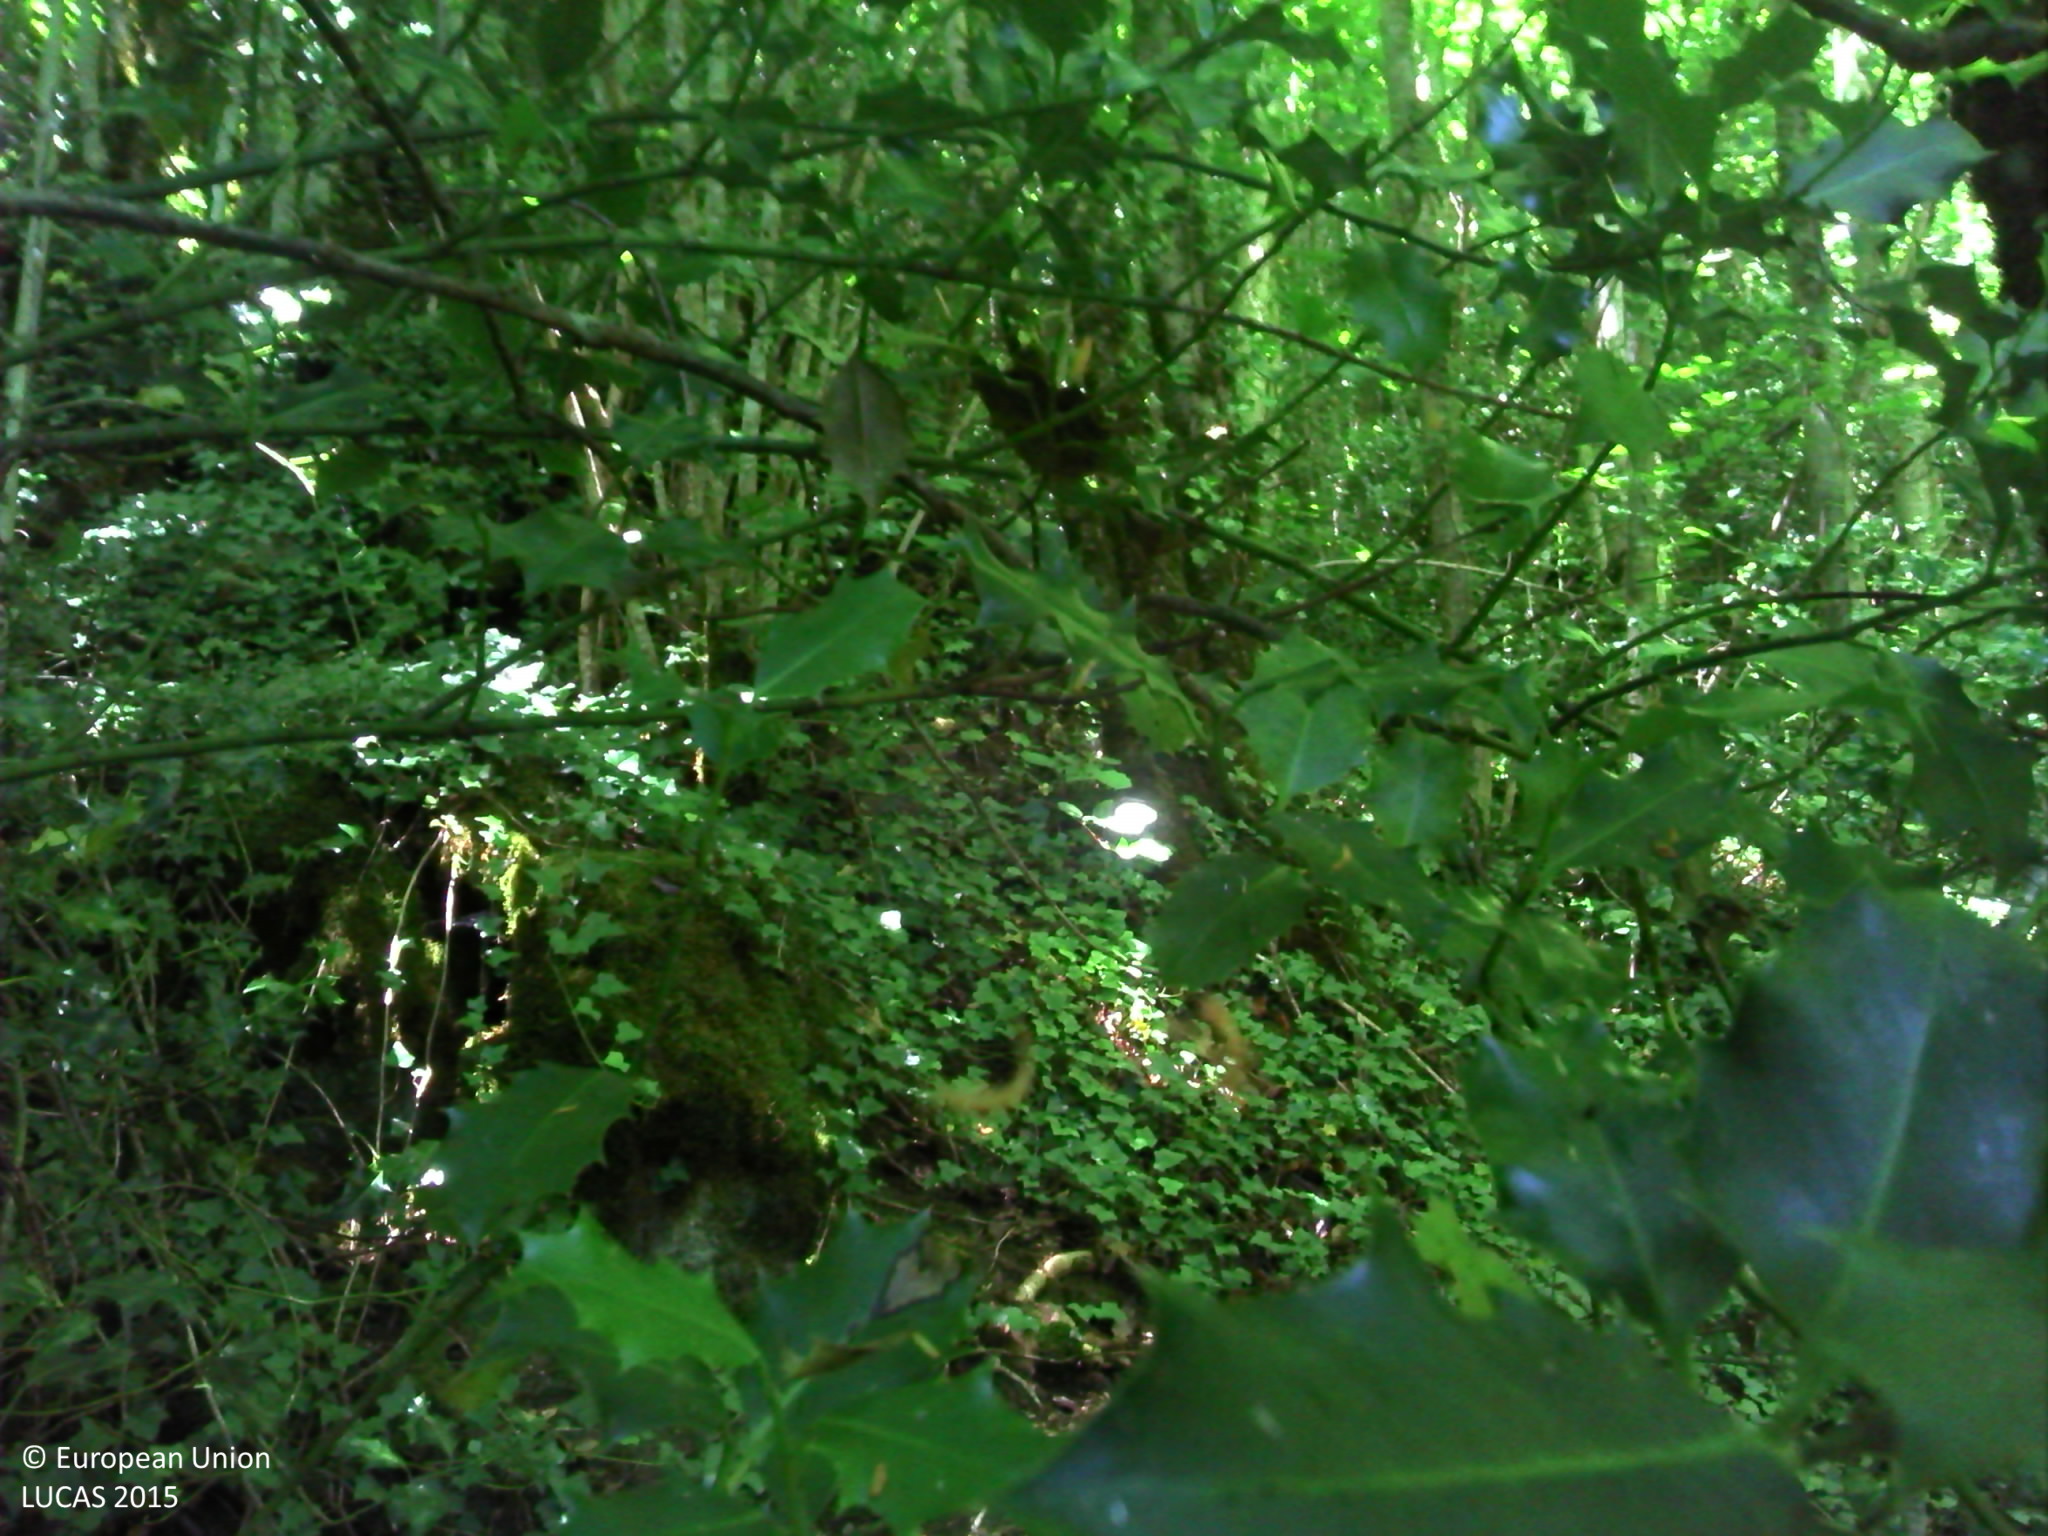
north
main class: Woodland
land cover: Broadleaved woodland
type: mesophytic deciduous forest
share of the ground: > 75 %
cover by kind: broadleaved forest trees 70 %, shrubs 25 %, herbaceous plants 5 %
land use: Semi-natural and natural areas not in use
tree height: > 5 m
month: June
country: FR
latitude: 45.1278
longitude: 2.4858
